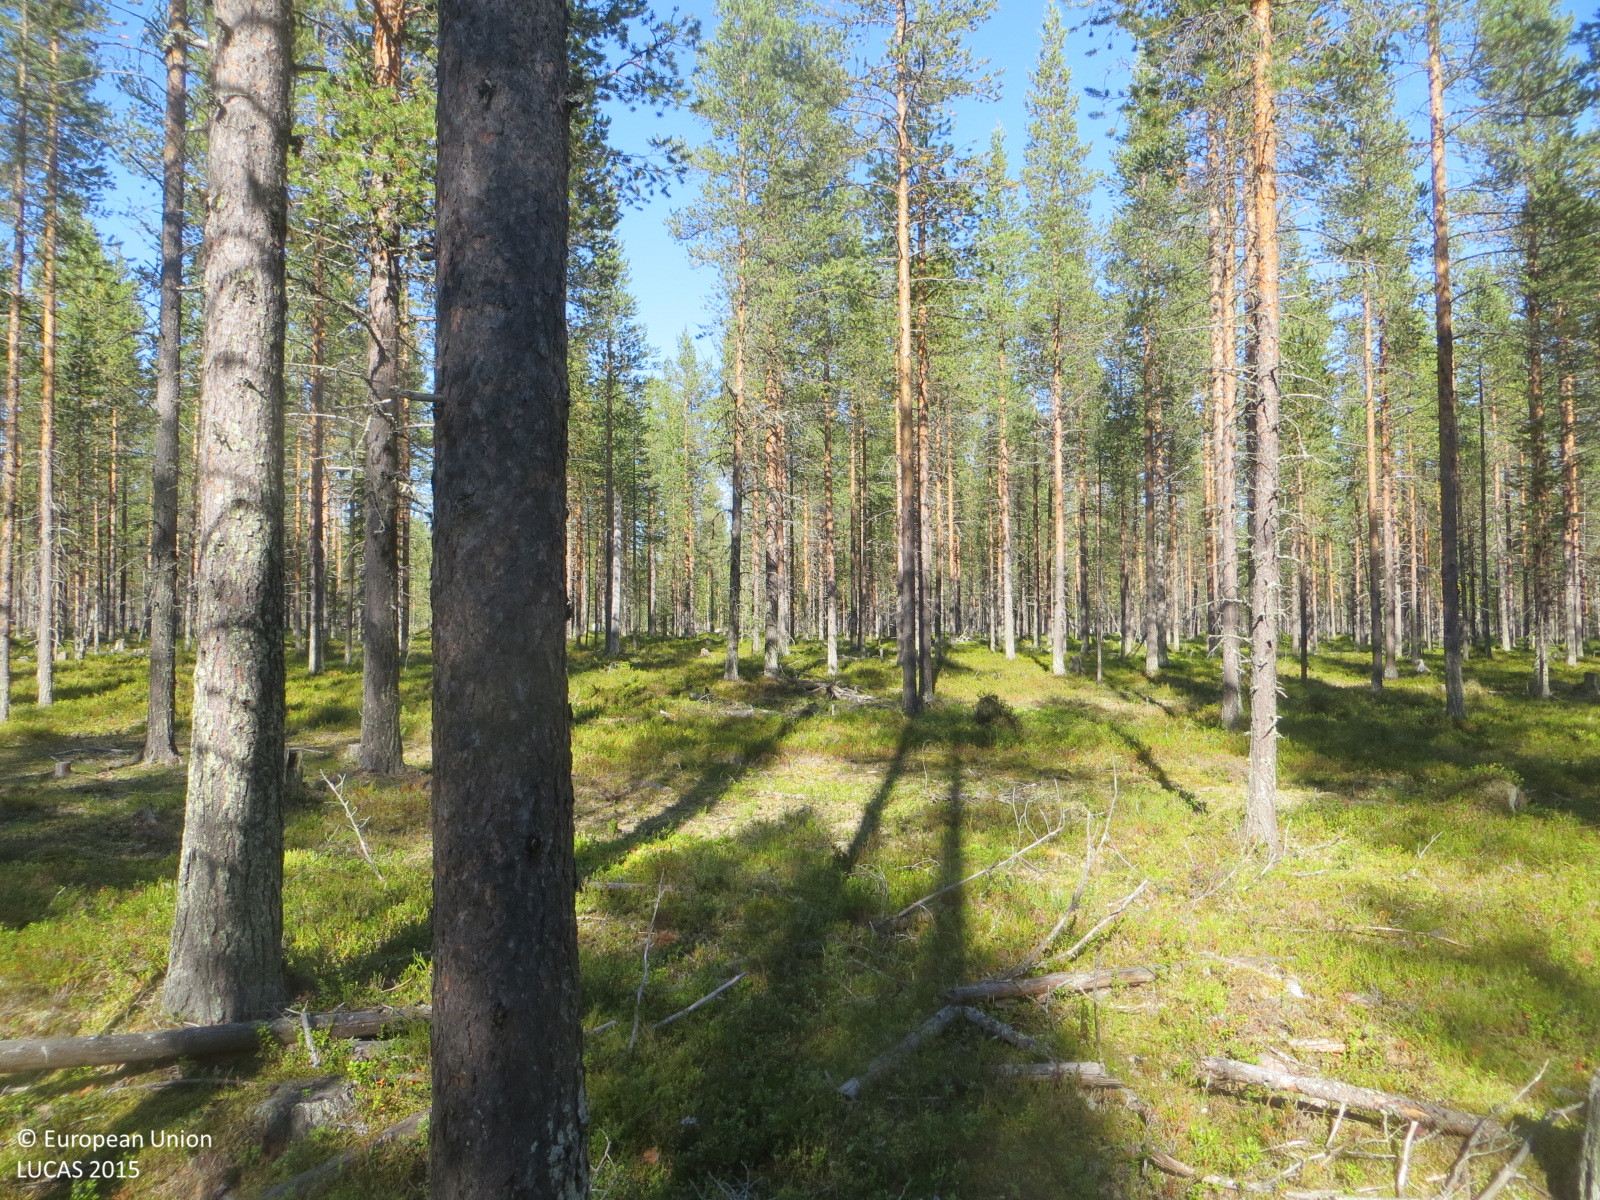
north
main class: Woodland
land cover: Pine dominated coniferous woodland
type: boreal forest
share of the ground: 50 - 75 %
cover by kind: coniferous forest trees 50 %, shrubs 50 %
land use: Forestry
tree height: > 5 m
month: August
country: FI
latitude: 67.5234
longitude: 23.9211
